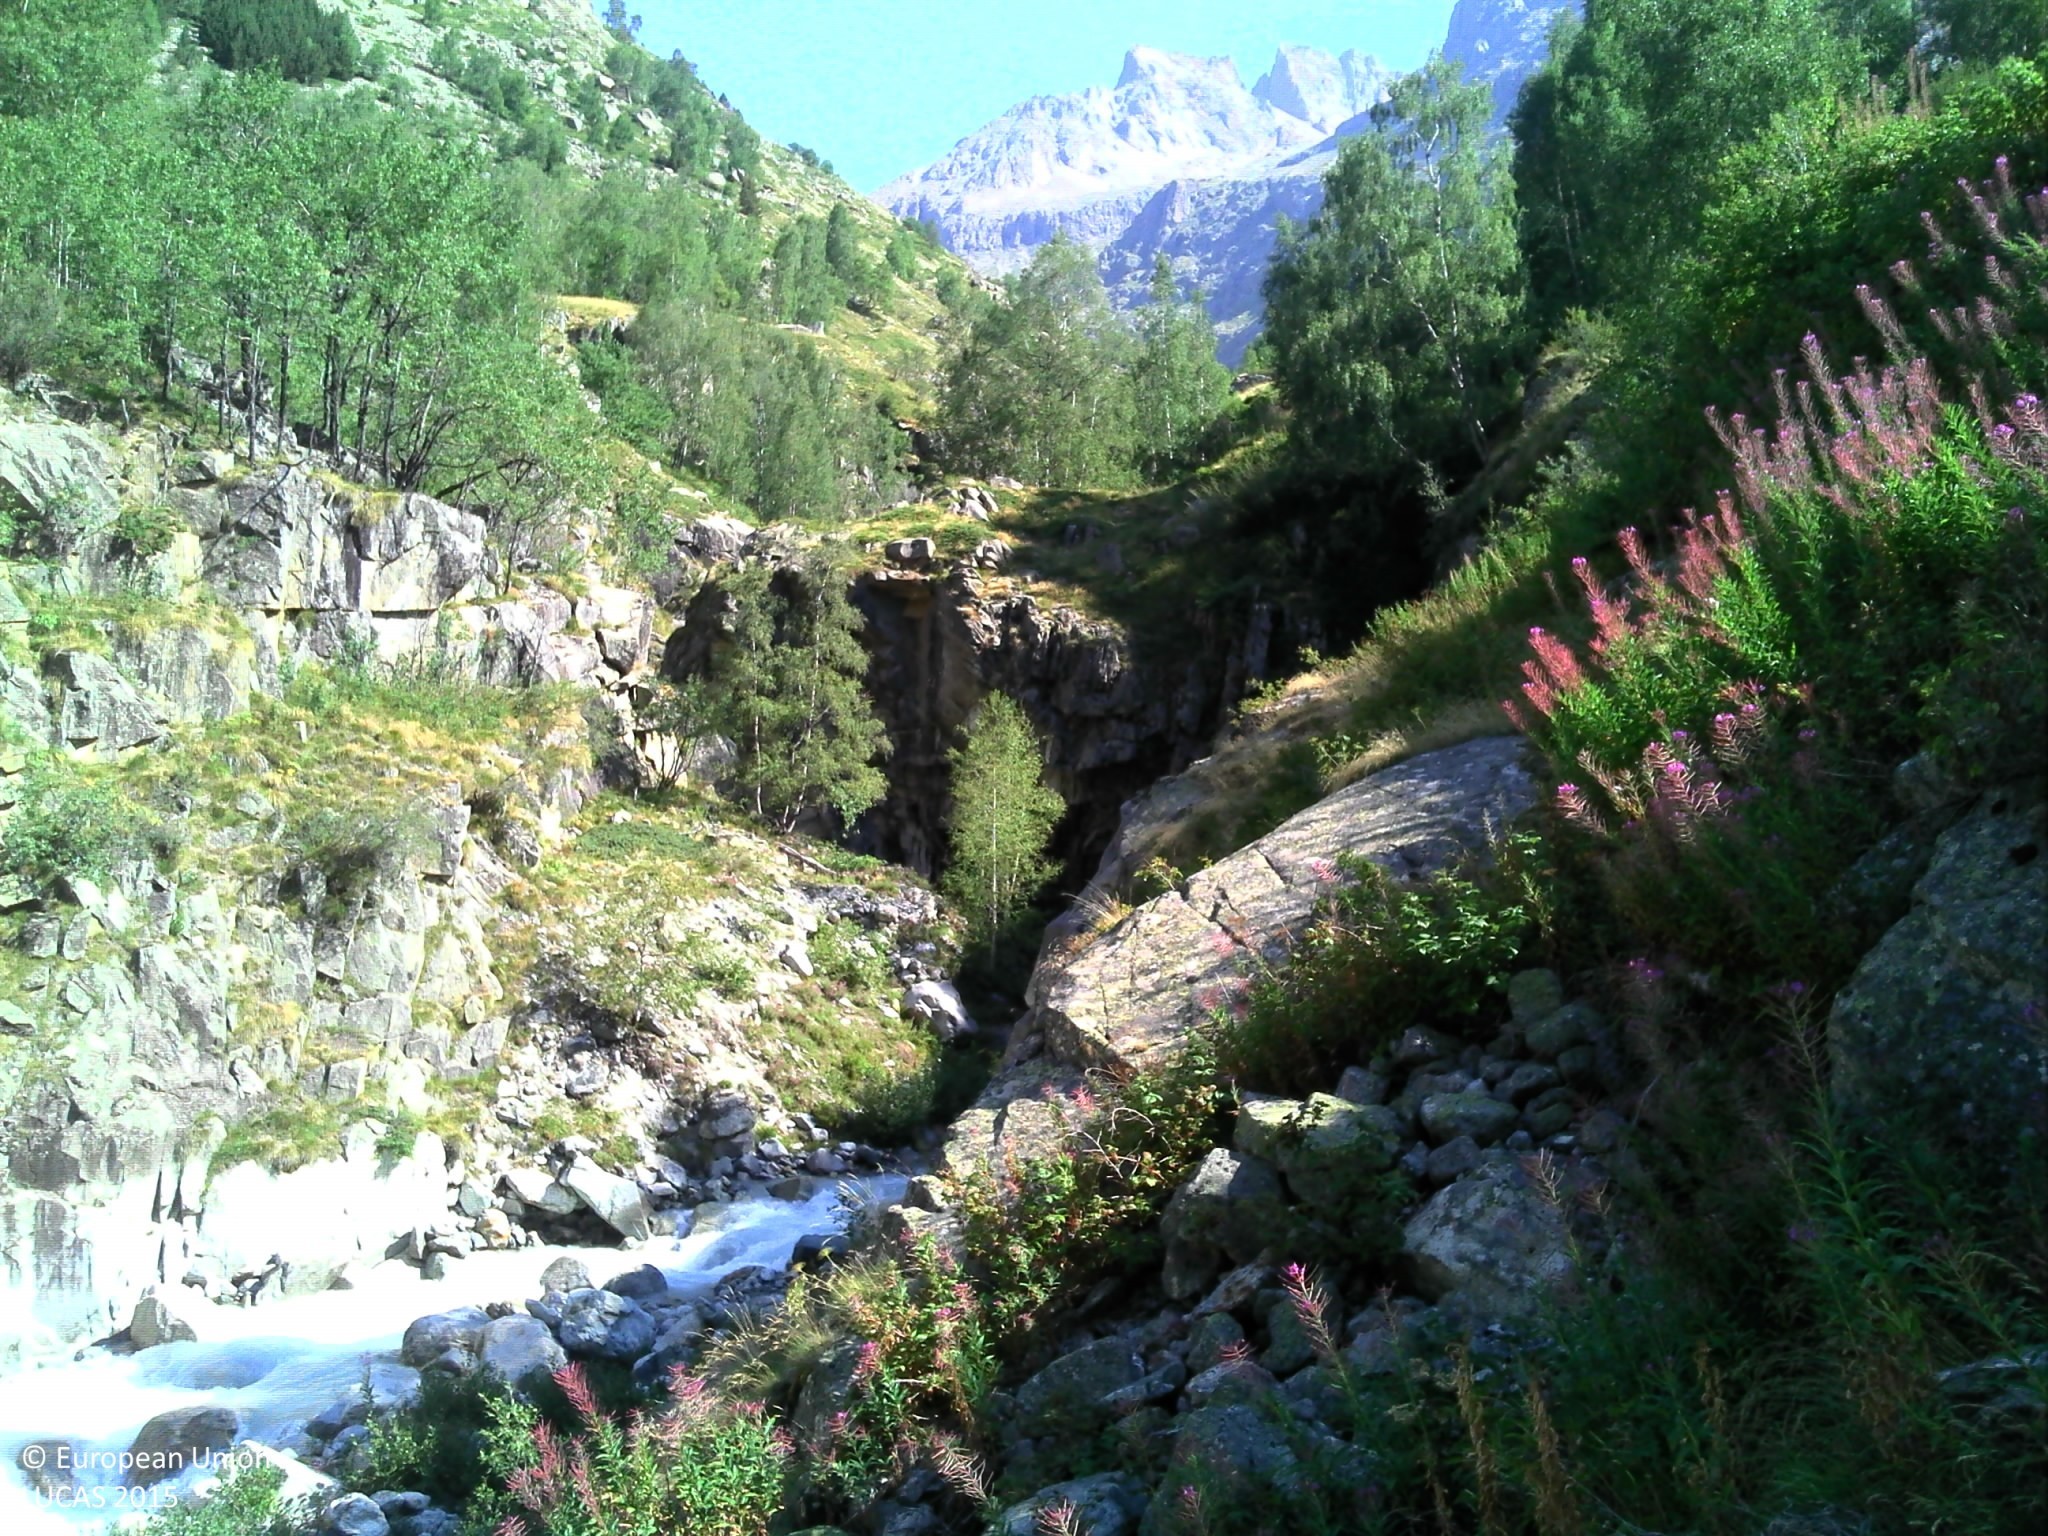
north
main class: Grassland
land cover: Grassland without tree/shrub cover
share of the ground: > 75 %
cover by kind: herbaceous plants 90 %, shrubs 5 %, unconsolidated bare surface 5 %
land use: Semi-natural and natural areas not in use
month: August
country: FR
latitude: 44.9342
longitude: 6.2930
